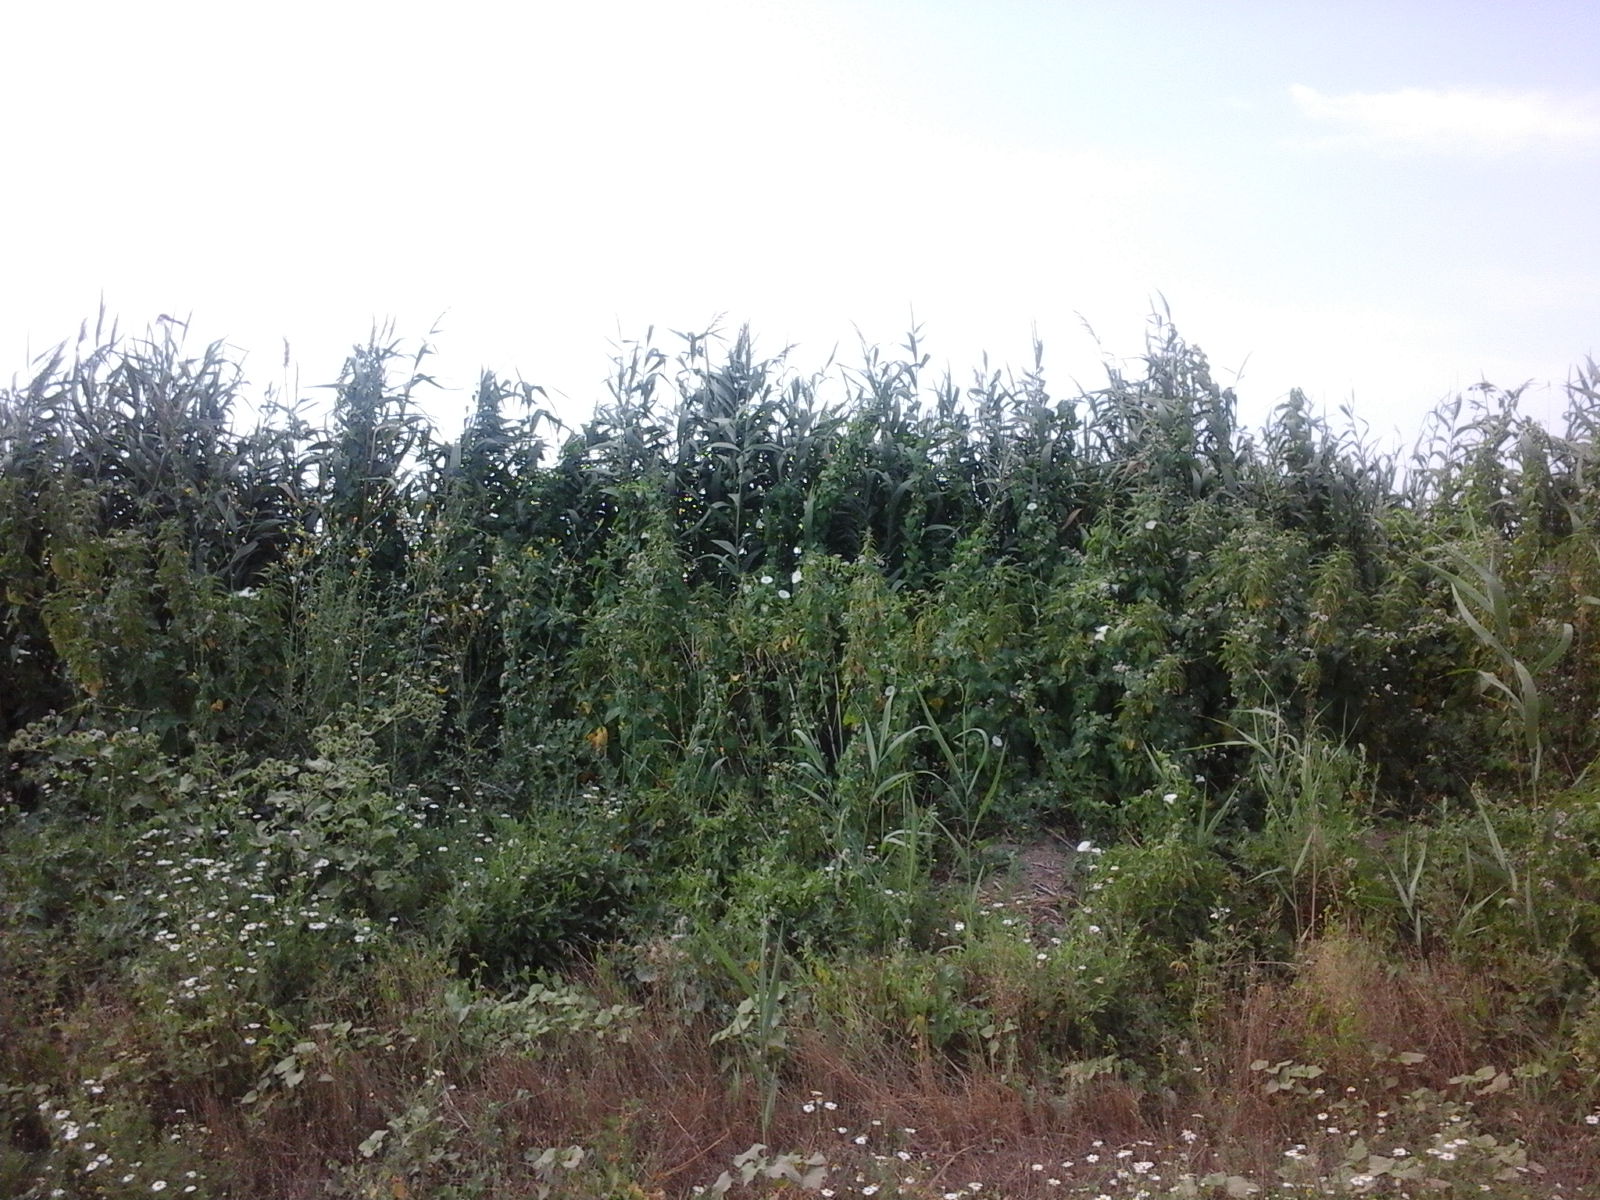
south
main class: Cropland
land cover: Maize
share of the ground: > 75 %
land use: Agriculture (excluding fallow land and kitchen gardens)
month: July
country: RO
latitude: 44.4677
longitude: 28.0461
